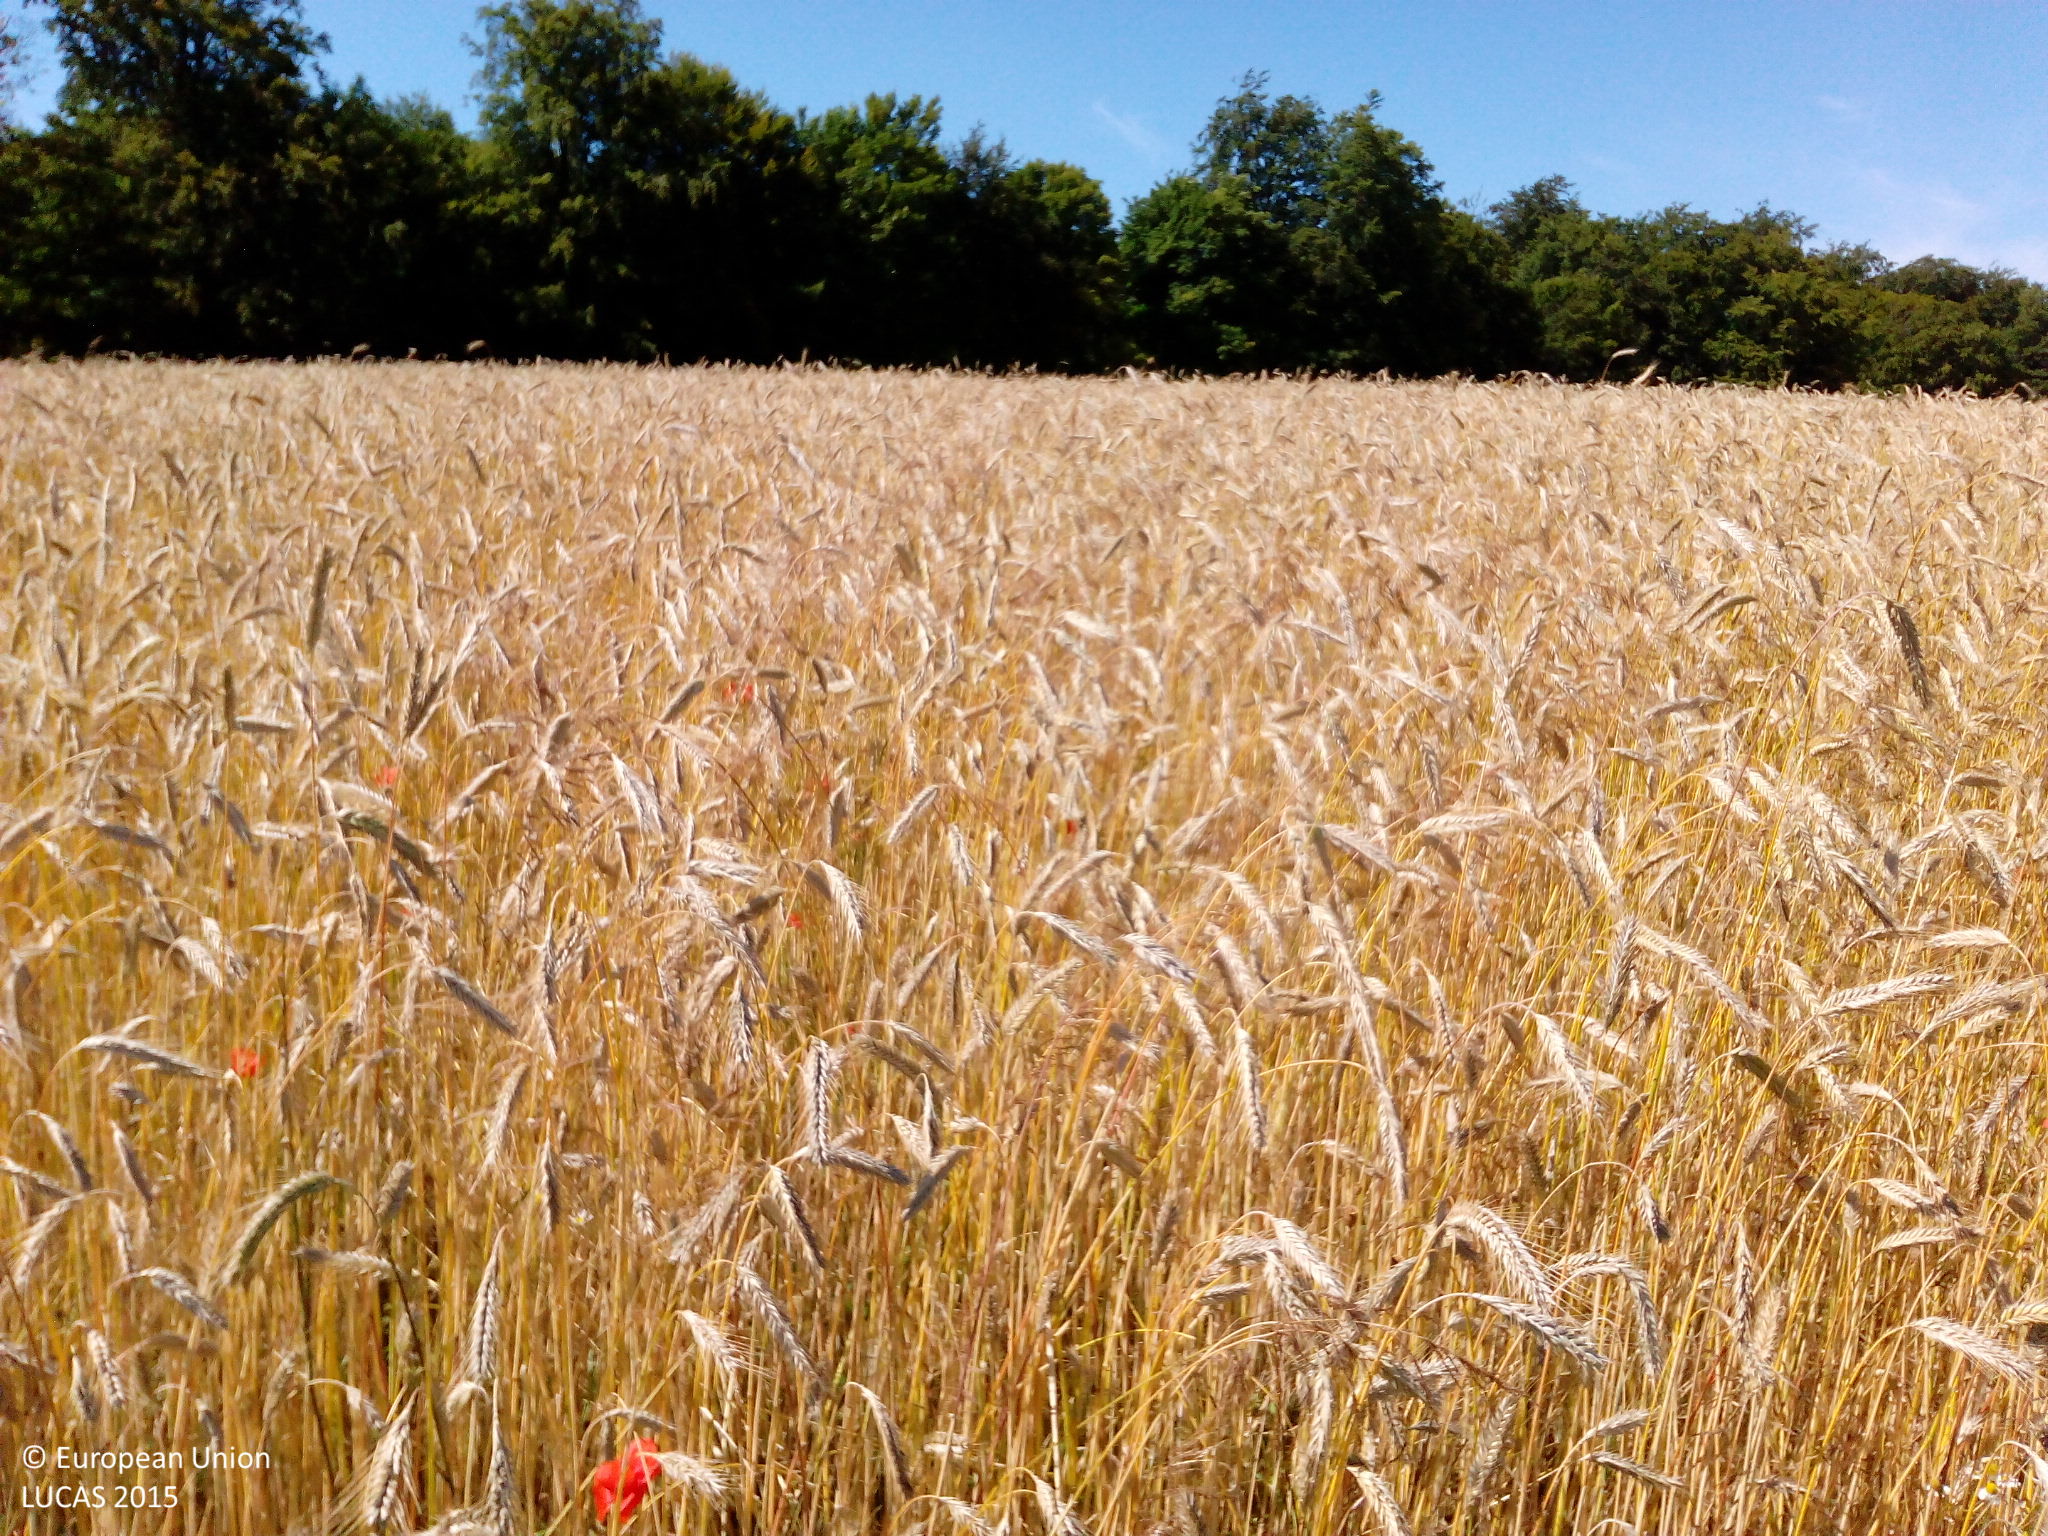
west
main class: Cropland
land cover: Rye
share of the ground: > 75 %
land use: Agriculture (excluding fallow land and kitchen gardens)
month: August
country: DK
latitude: 55.5806
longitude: 11.8861
